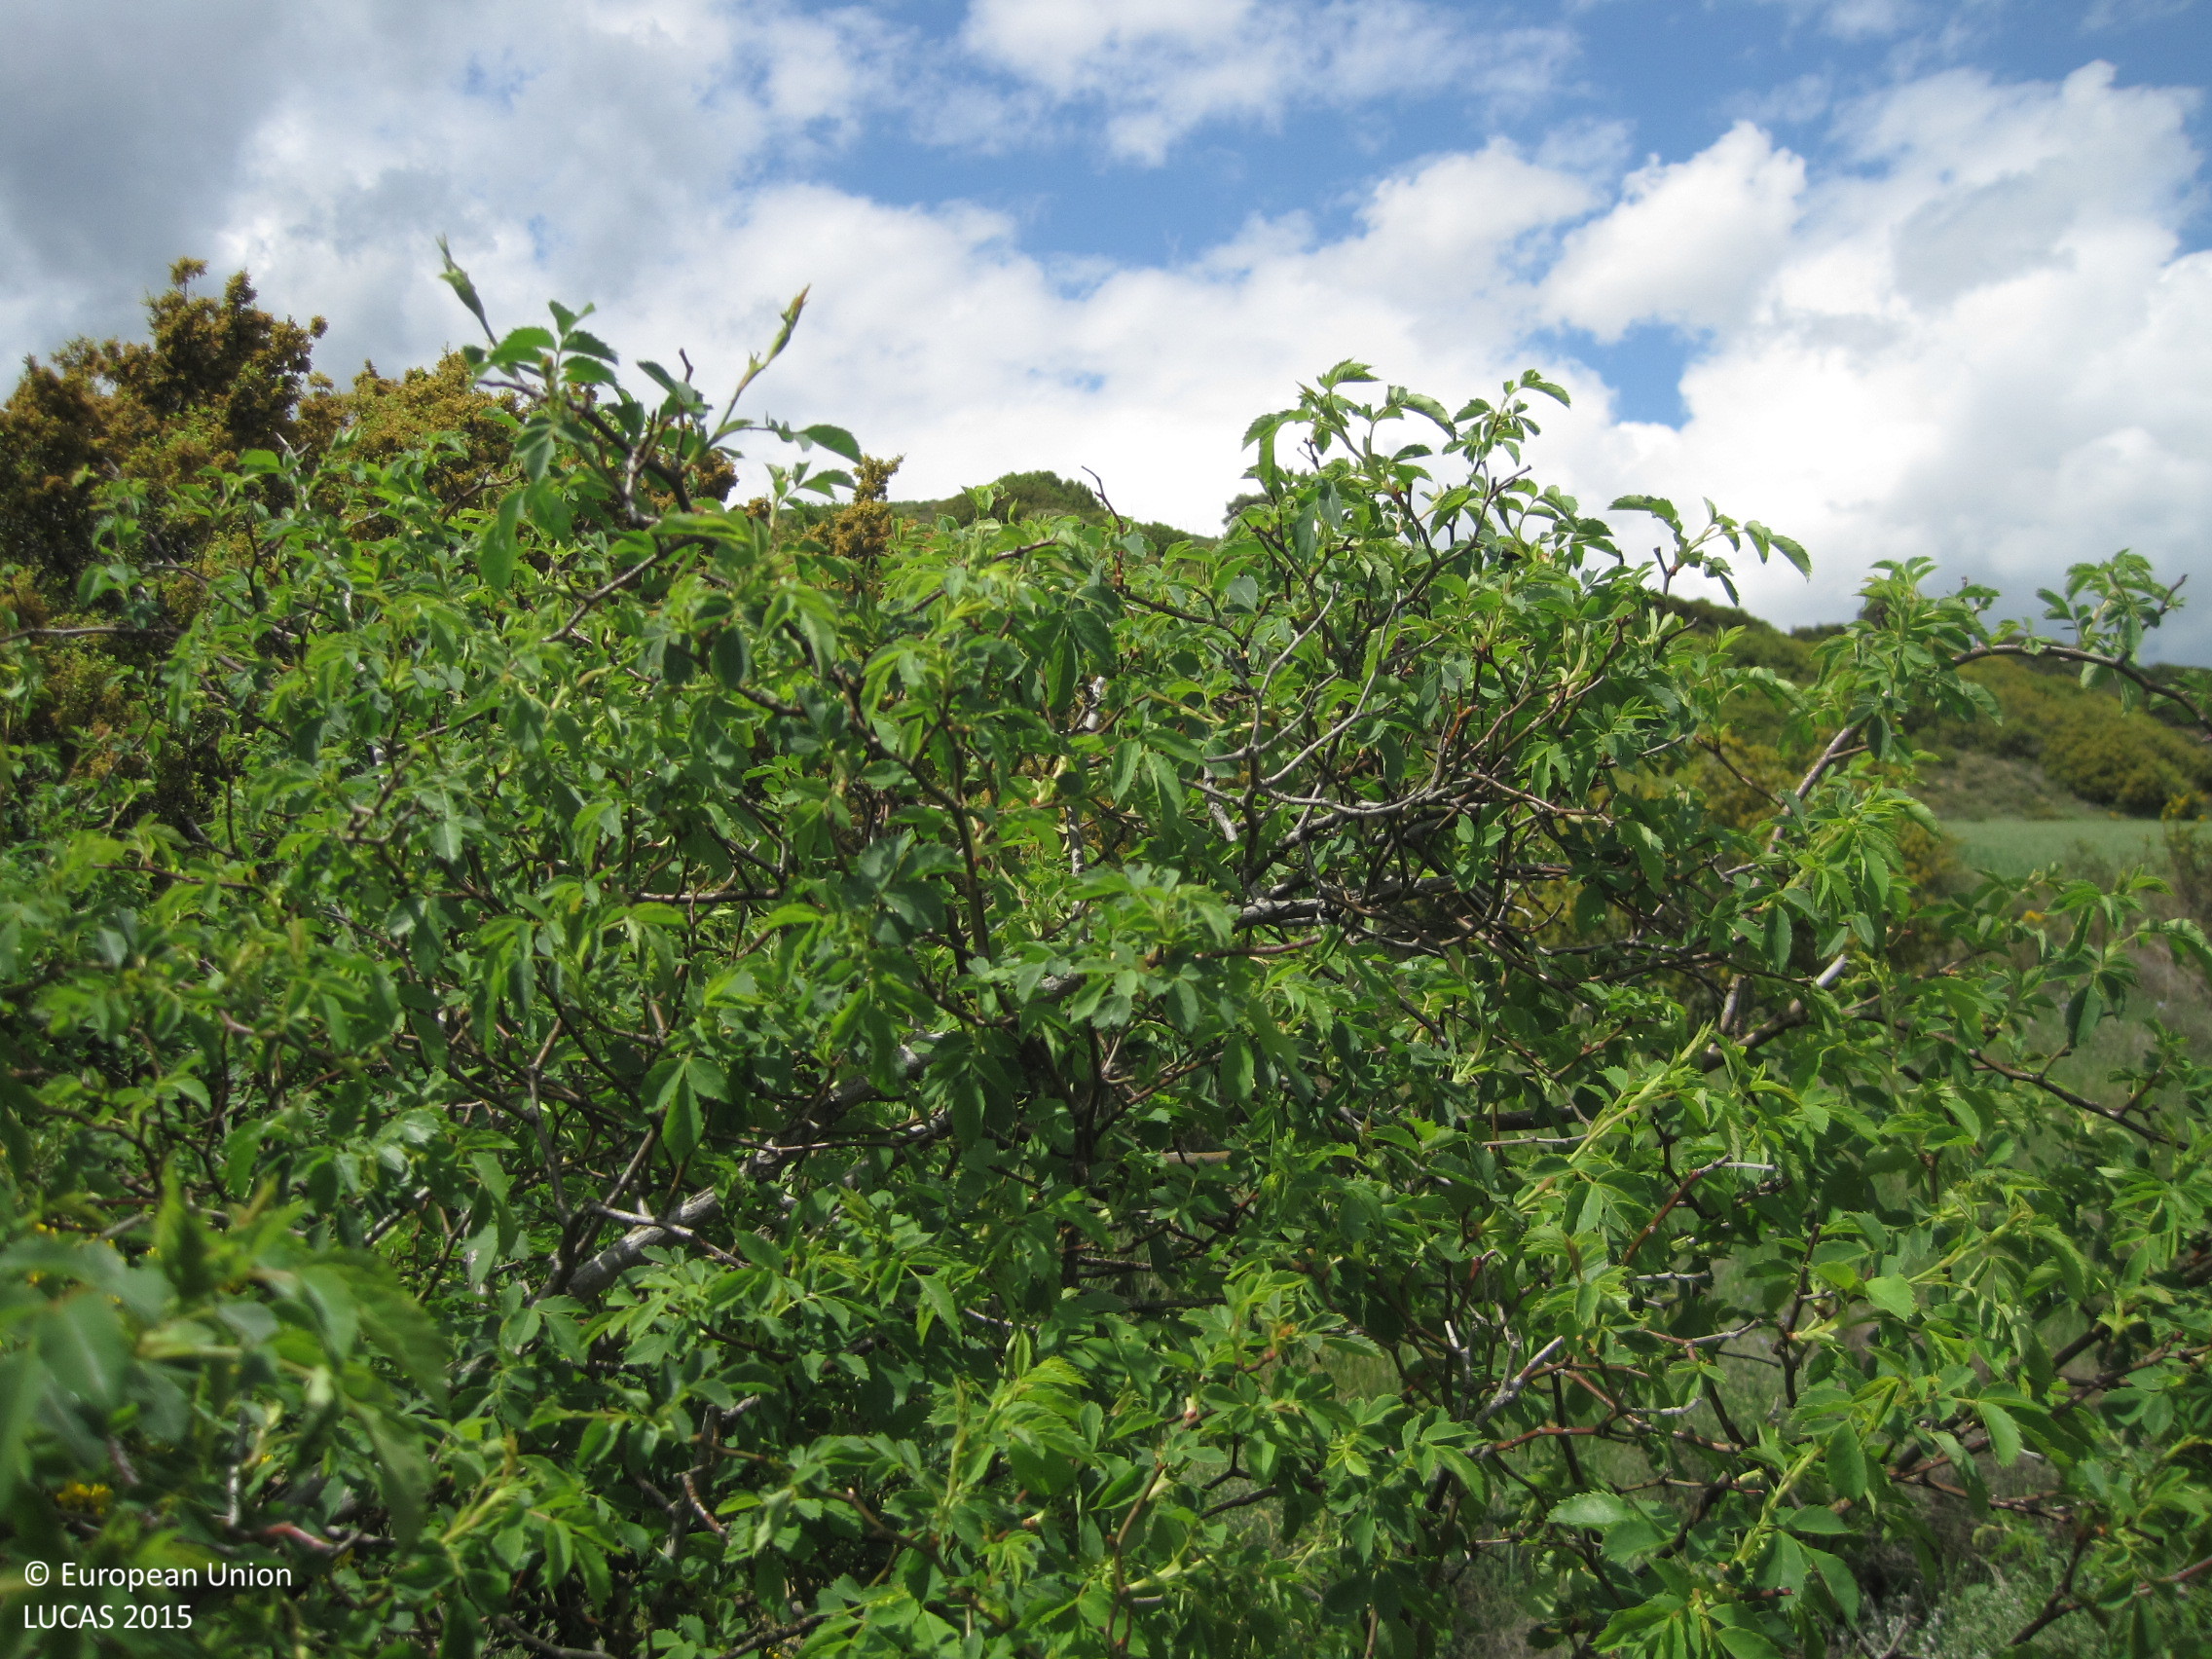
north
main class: Woodland
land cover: Broadleaved woodland
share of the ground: 25 - 50 %
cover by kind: shrubs 70 %, broadleaved forest trees 30 %
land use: Semi-natural and natural areas not in use
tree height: < 5 m
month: May
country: ES
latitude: 42.7001
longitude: -1.7215
